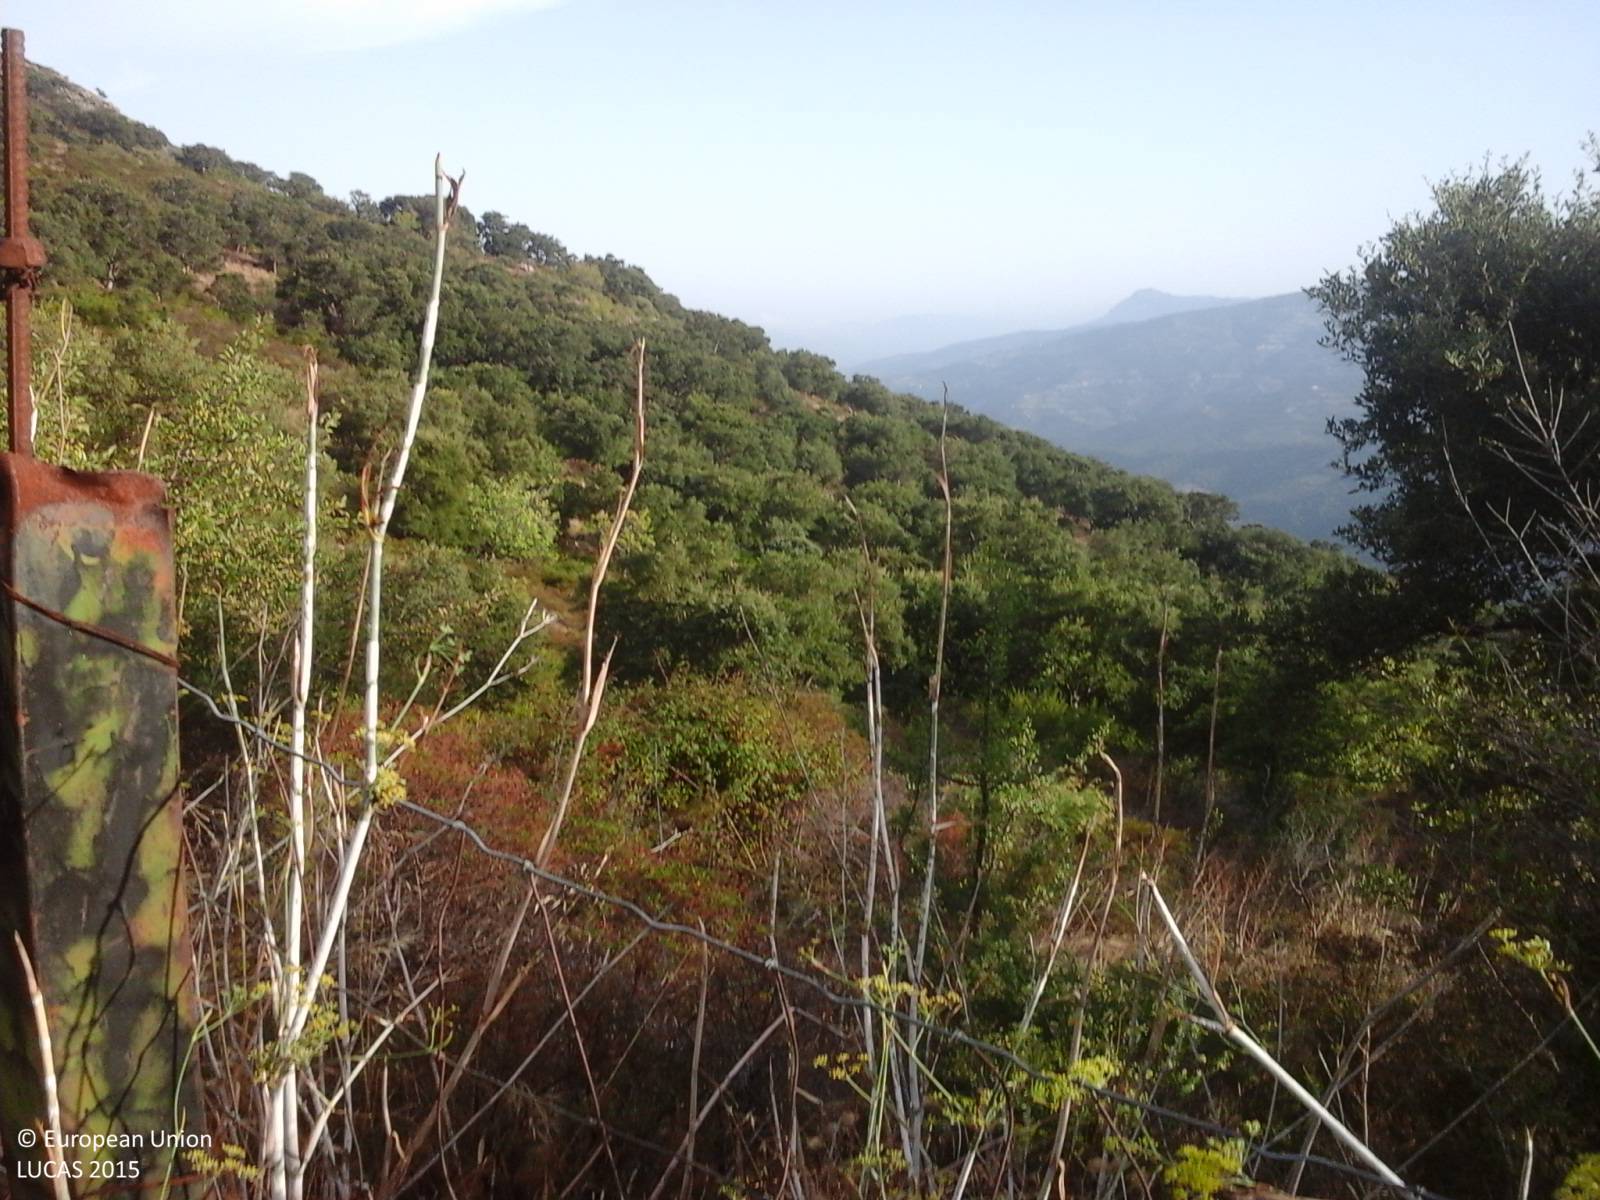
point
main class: Woodland
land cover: Broadleaved woodland
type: broadleaved evergreen forest
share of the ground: > 75 %
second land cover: Grassland without tree/shrub cover
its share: > 75 %
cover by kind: broadleaved forest trees 35 %, herbaceous plants 25 %, unconsolidated bare surface 20 %, shrubs 15 %, consolidated bare surface 5 %
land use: Agriculture (excluding fallow land and kitchen gardens)
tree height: > 5 m
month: September
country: IT
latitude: 39.8316
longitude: 9.5236
